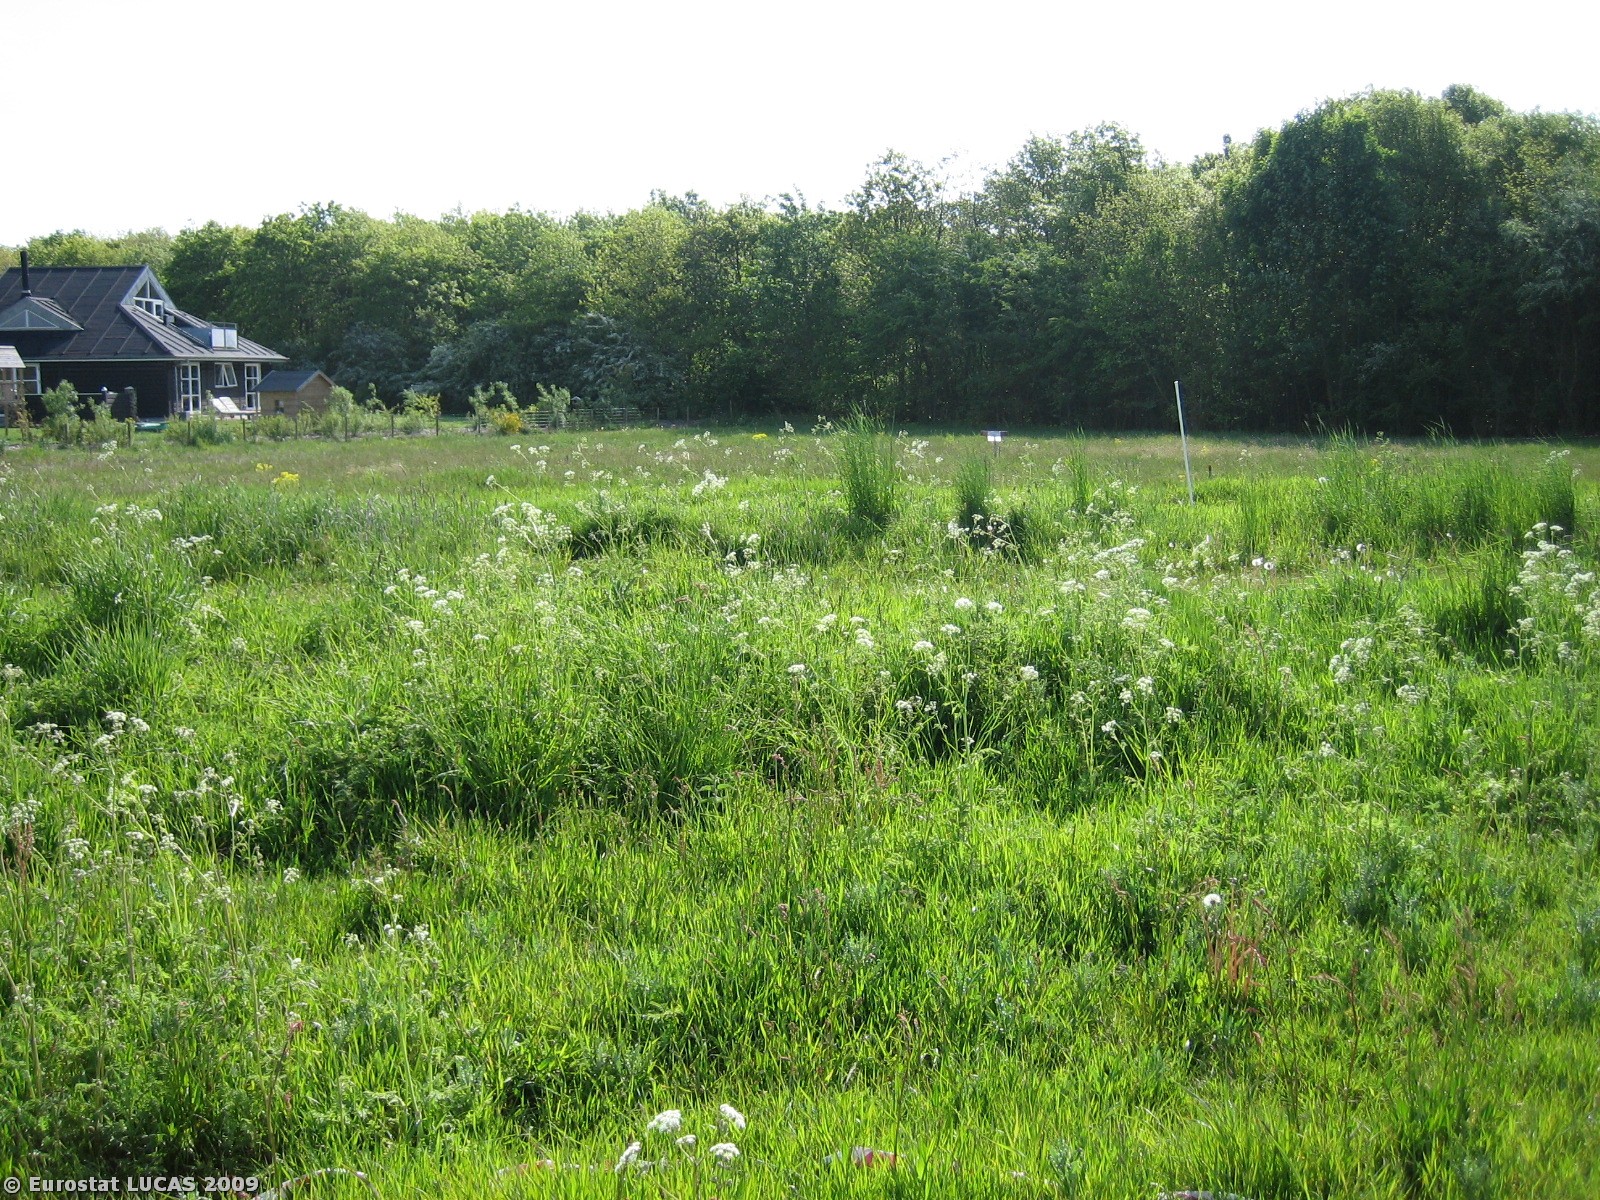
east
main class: Grassland
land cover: Grassland without tree/shrub cover
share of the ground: > 75 %
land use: Construction
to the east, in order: Grassland without tree/shrub cover; Tracks; Grassland without tree/shrub cover; Tracks; Broadleaved woodland; Tracks; Broadleaved woodland; Grassland without tree/shrub cover; Inland marshes; Ditches and canals; Grassland without tree/shrub cover
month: May
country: DK
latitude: 56.1658
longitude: 8.9866
